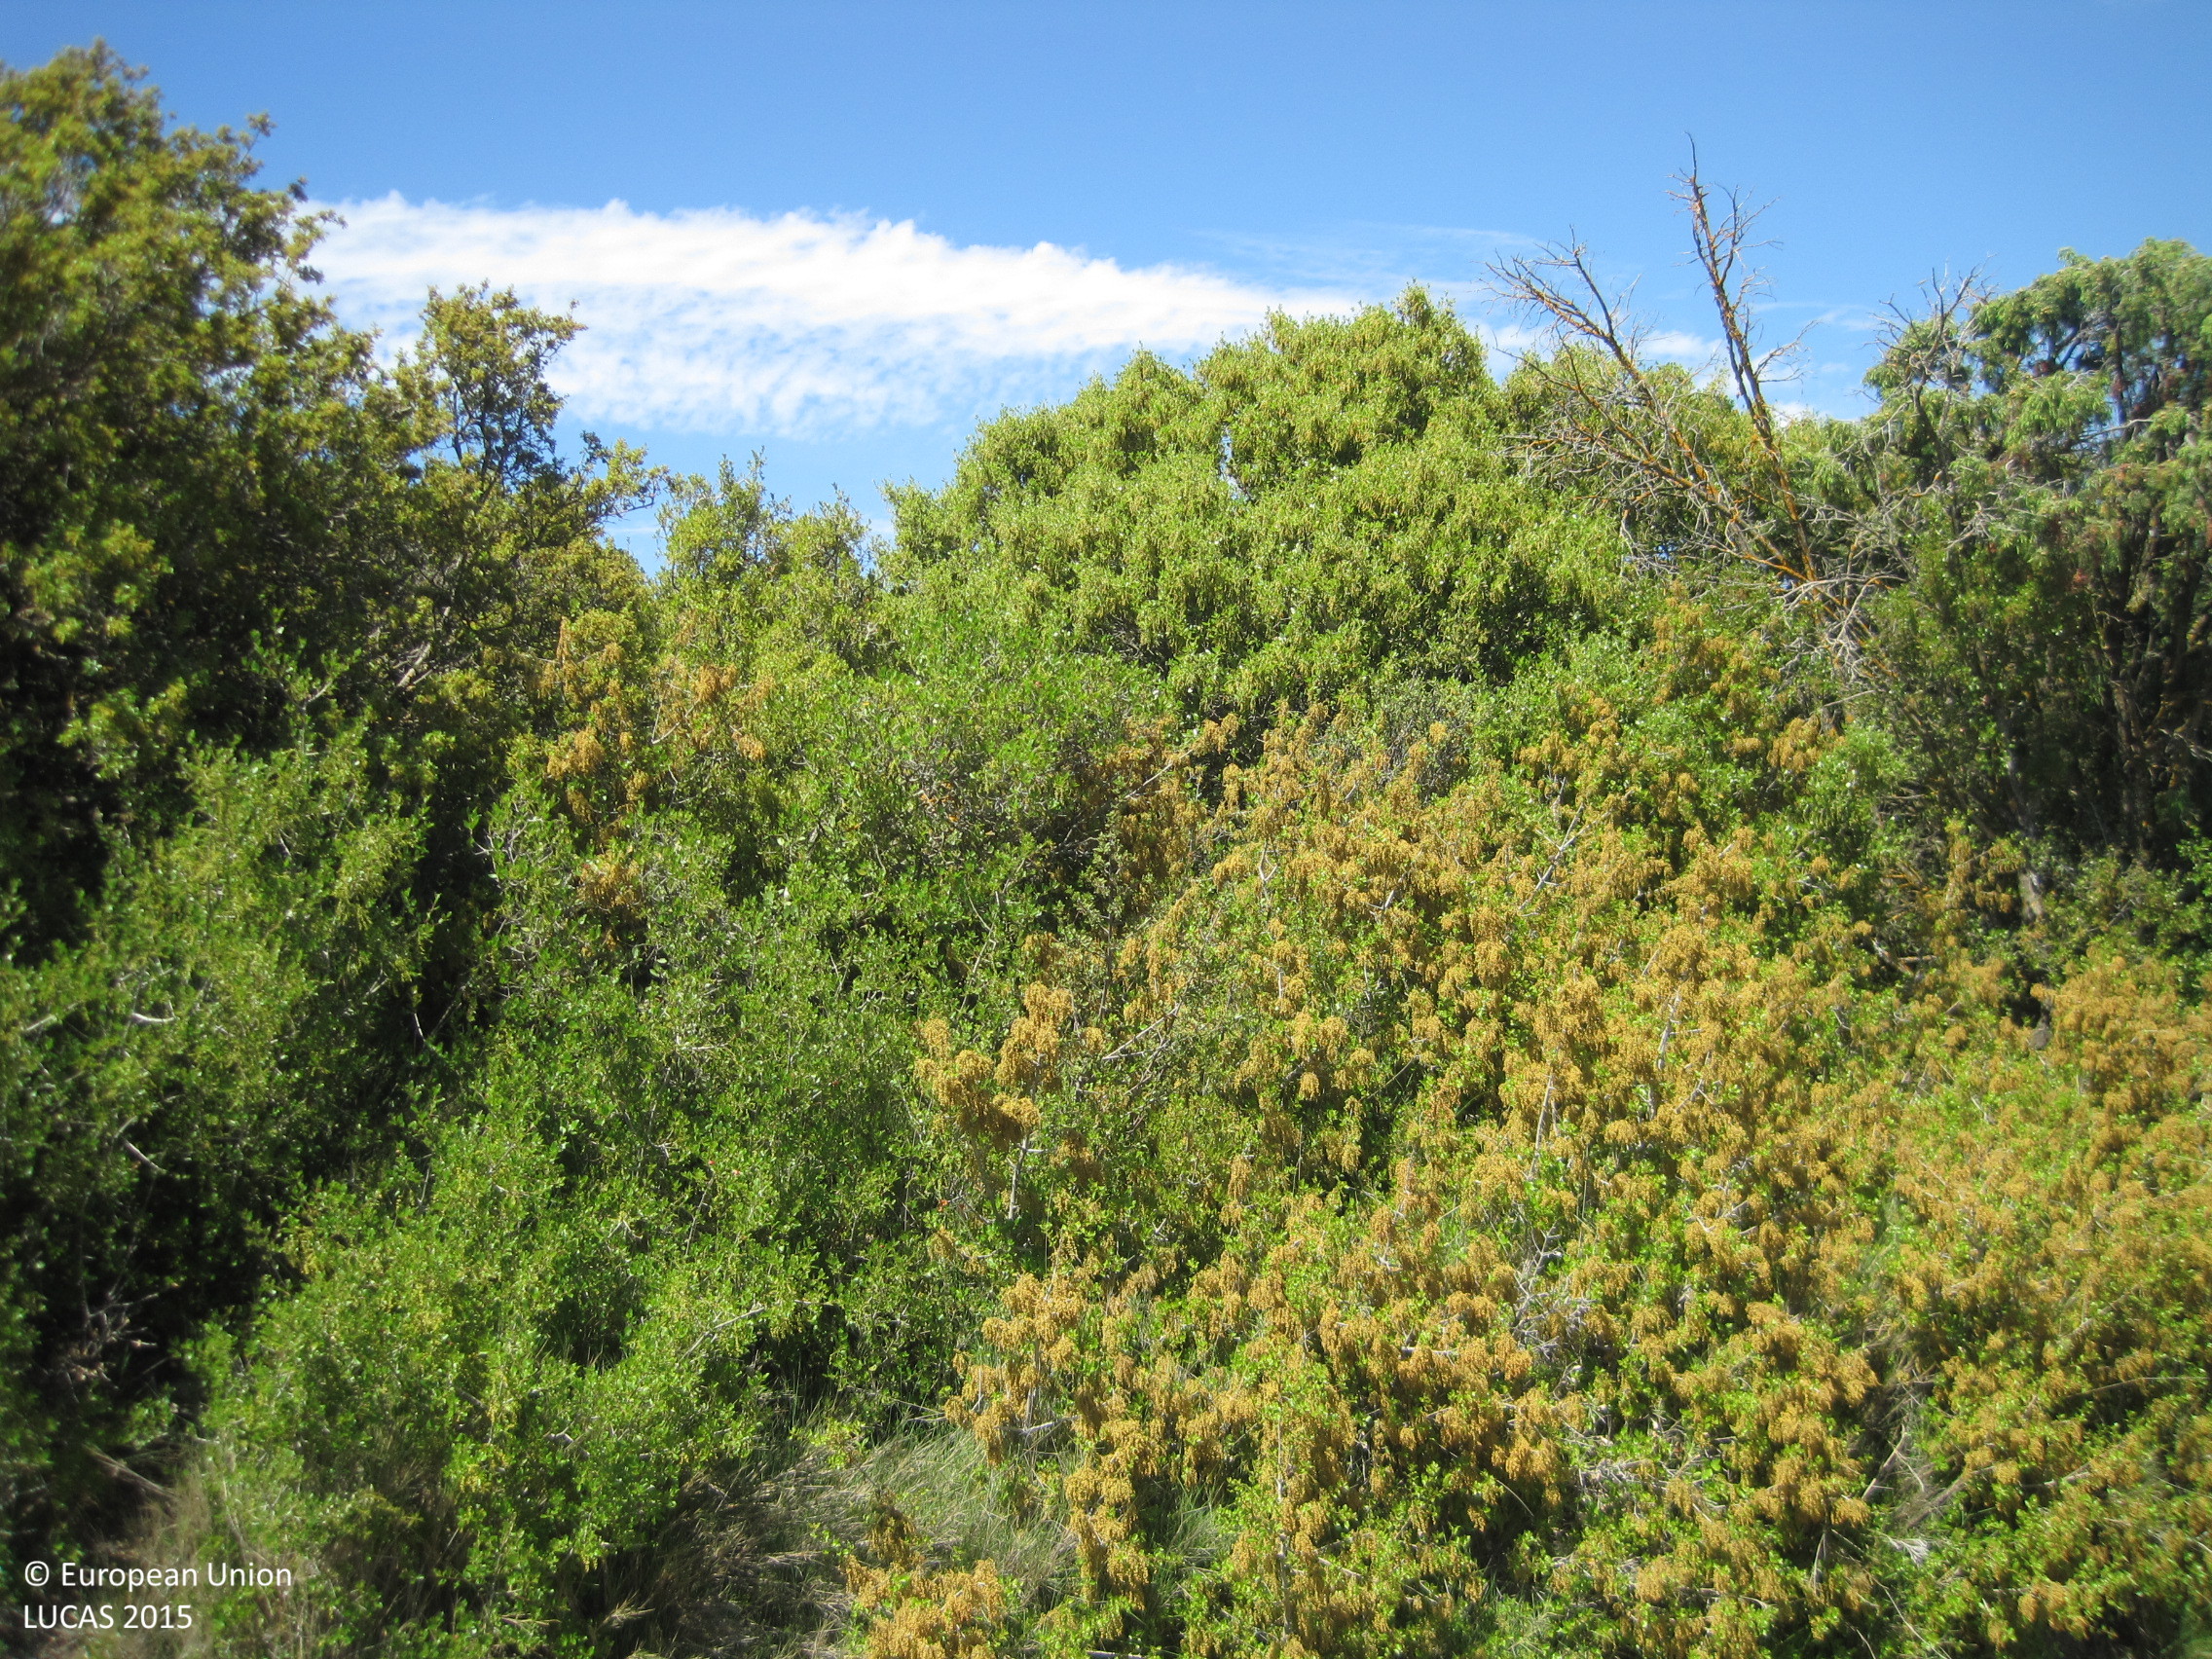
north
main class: Grassland
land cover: Spontaneously vegetated surfaces
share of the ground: > 75 %
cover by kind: herbaceous plants 60 %, unconsolidated bare surface 40 %
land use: Fallow land
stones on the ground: < 10 %
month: May
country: ES
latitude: 42.5303
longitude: -1.6141
